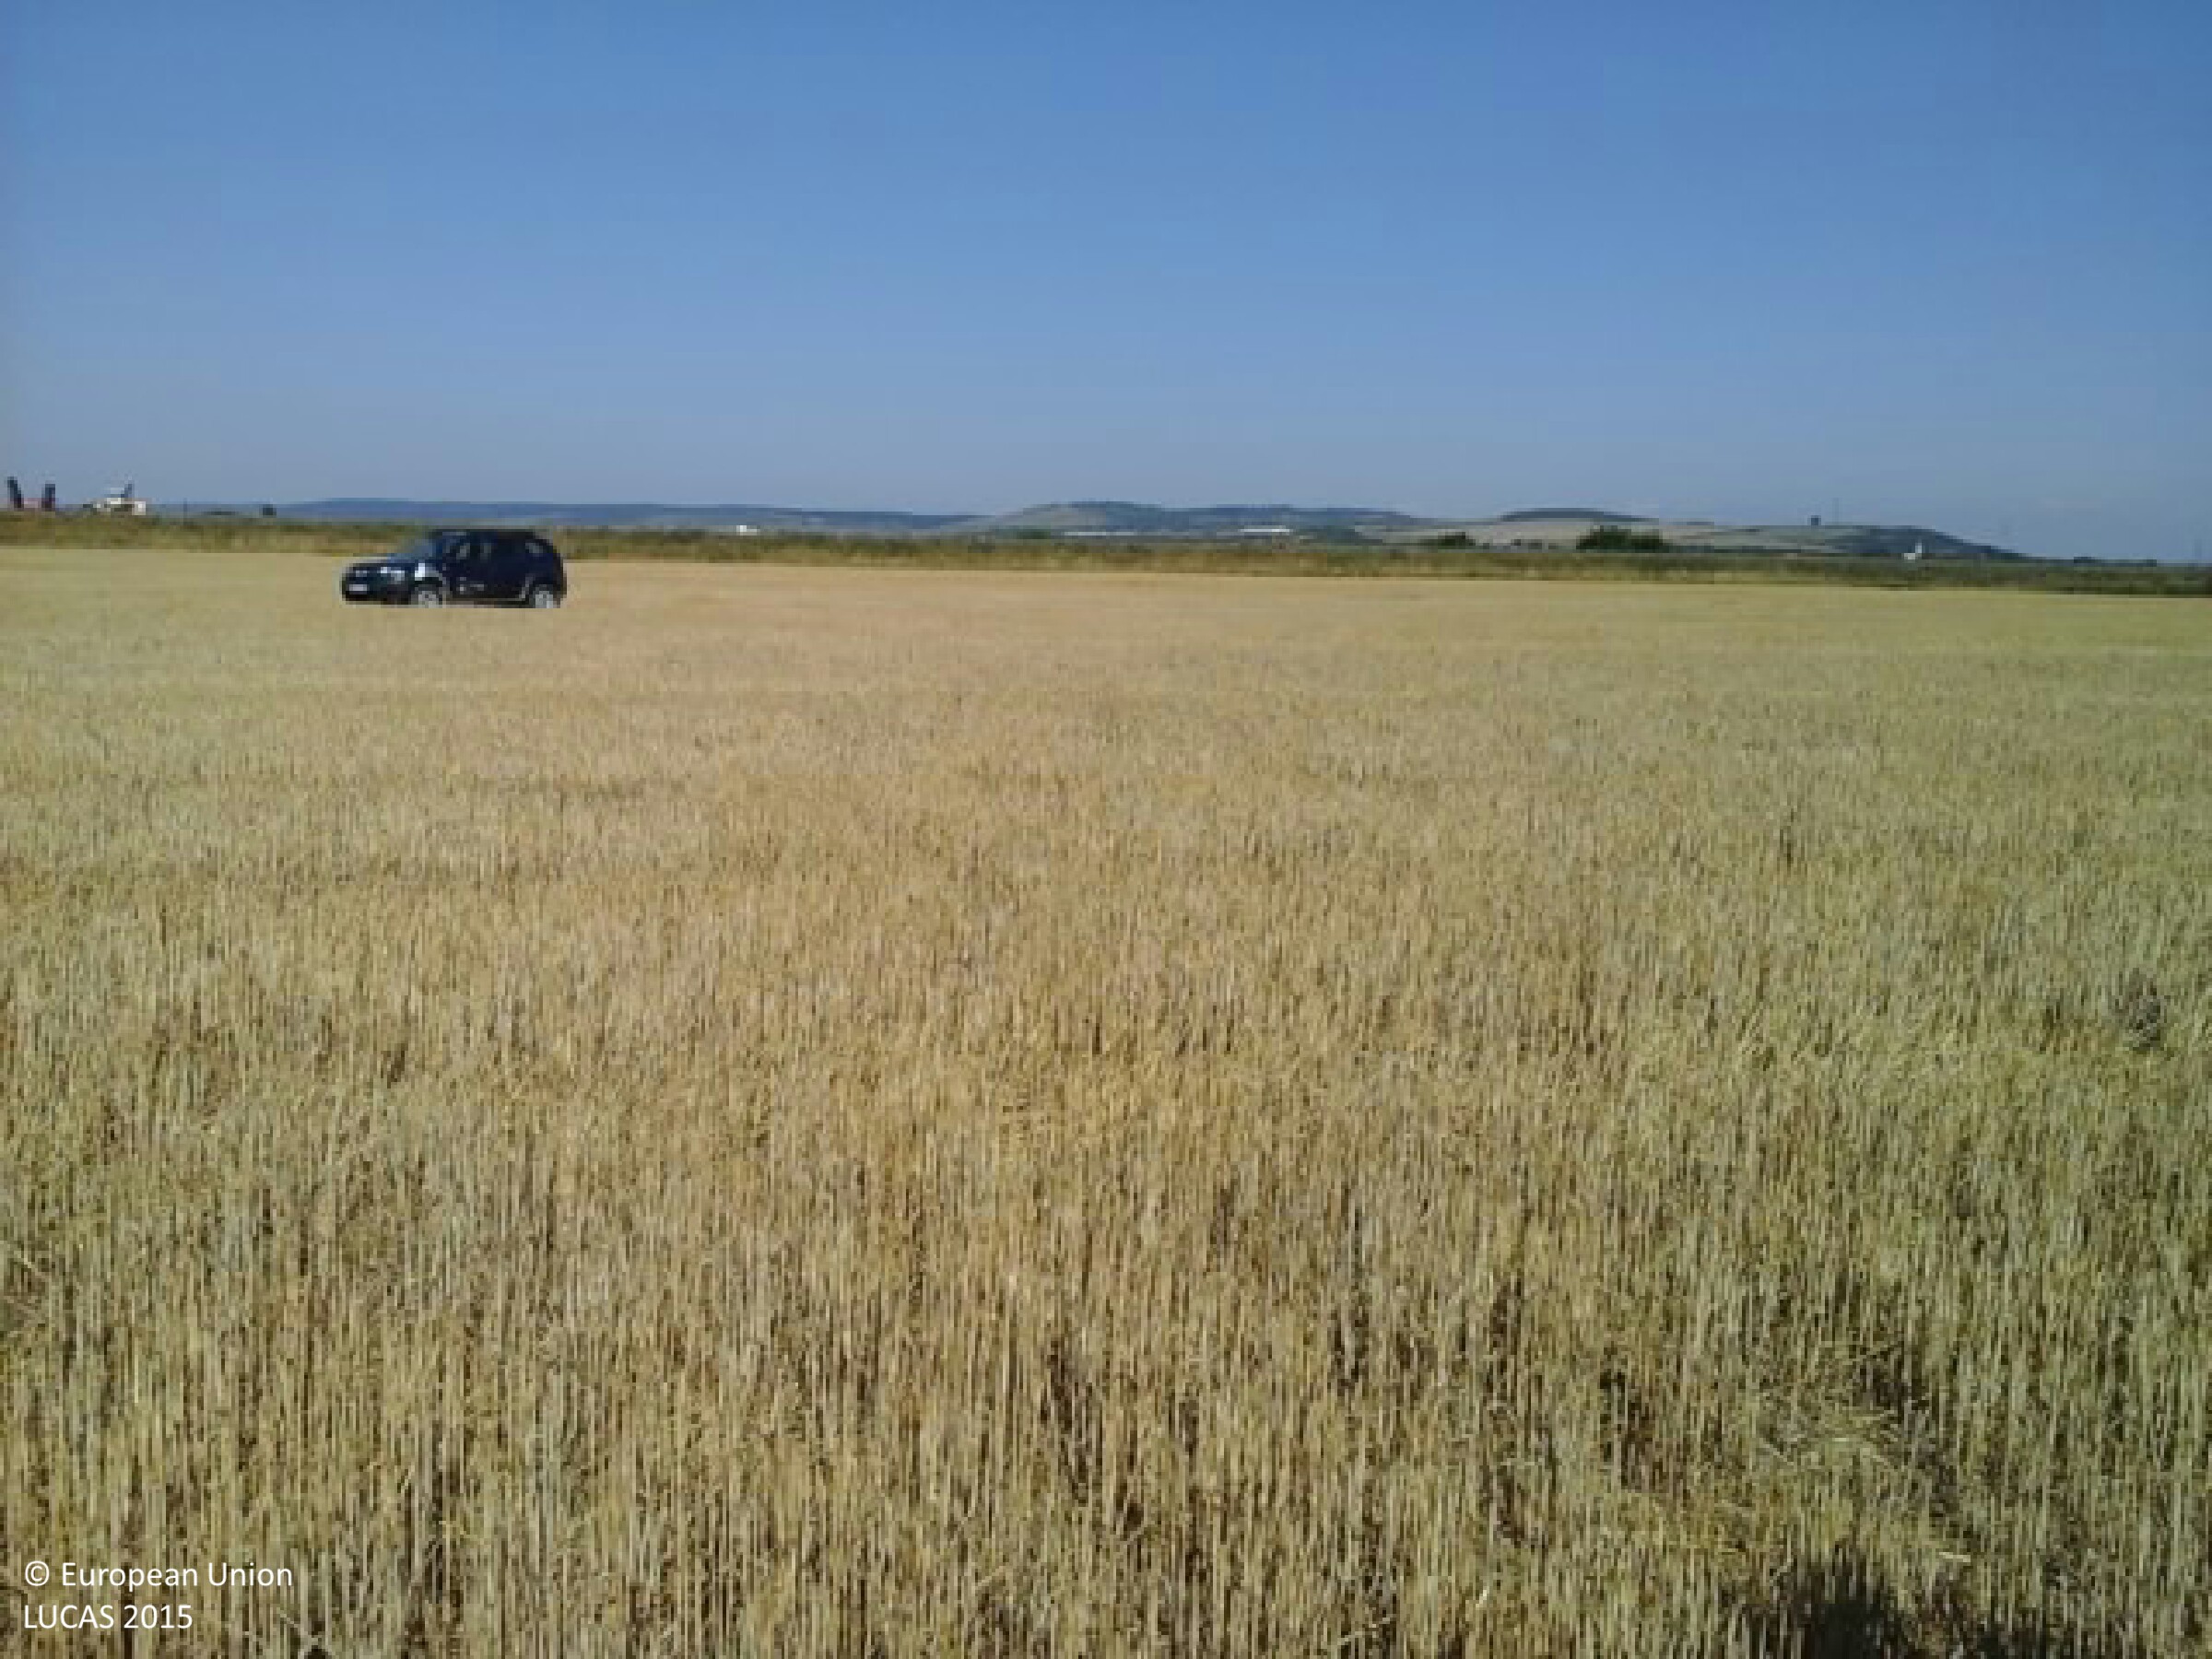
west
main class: Cropland
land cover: Common wheat
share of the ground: > 75 %
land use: Agriculture (excluding fallow land and kitchen gardens)
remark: Harvested field
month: July
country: HU
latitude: 48.2672
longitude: 20.6655
